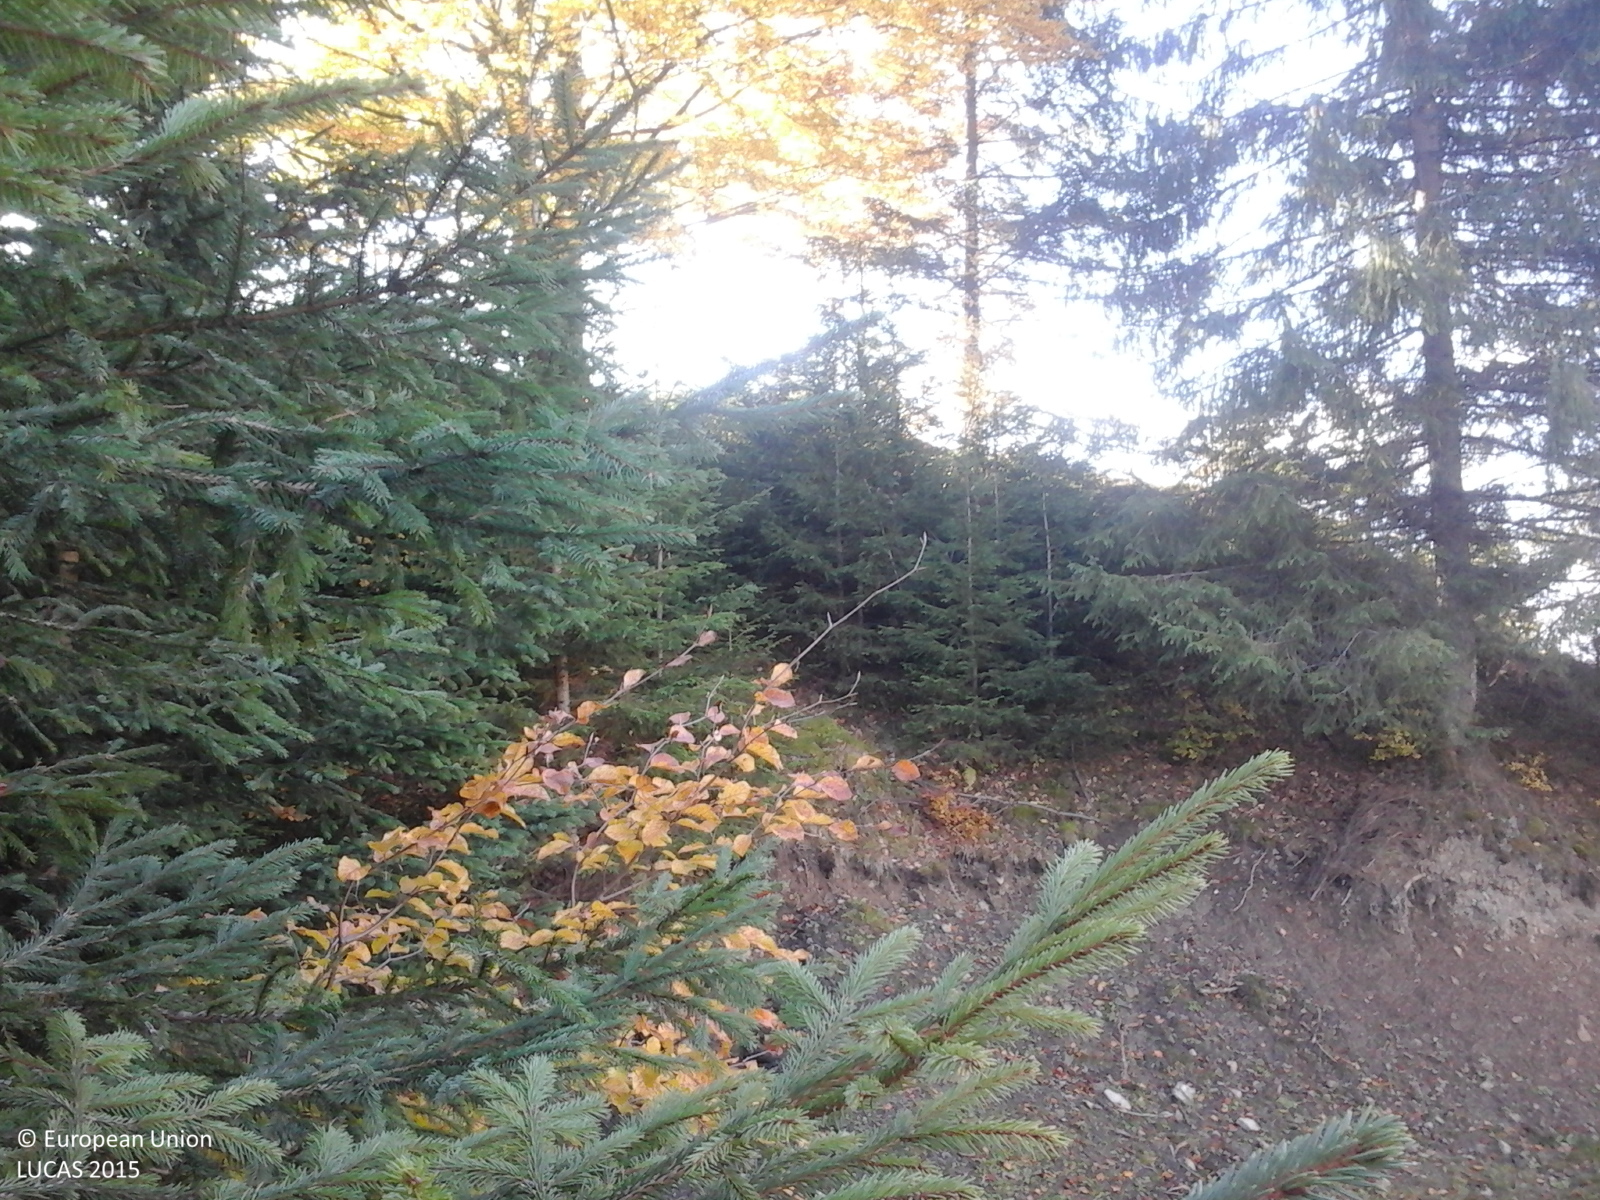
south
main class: Woodland
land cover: Spruce dominated coniferous woodland
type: alpine coniferous forest
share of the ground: > 75 %
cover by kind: coniferous forest trees 75 %, broadleaved forest trees 25 %
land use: Forestry
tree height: > 5 m
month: October
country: RO
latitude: 45.9660
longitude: 26.4526
